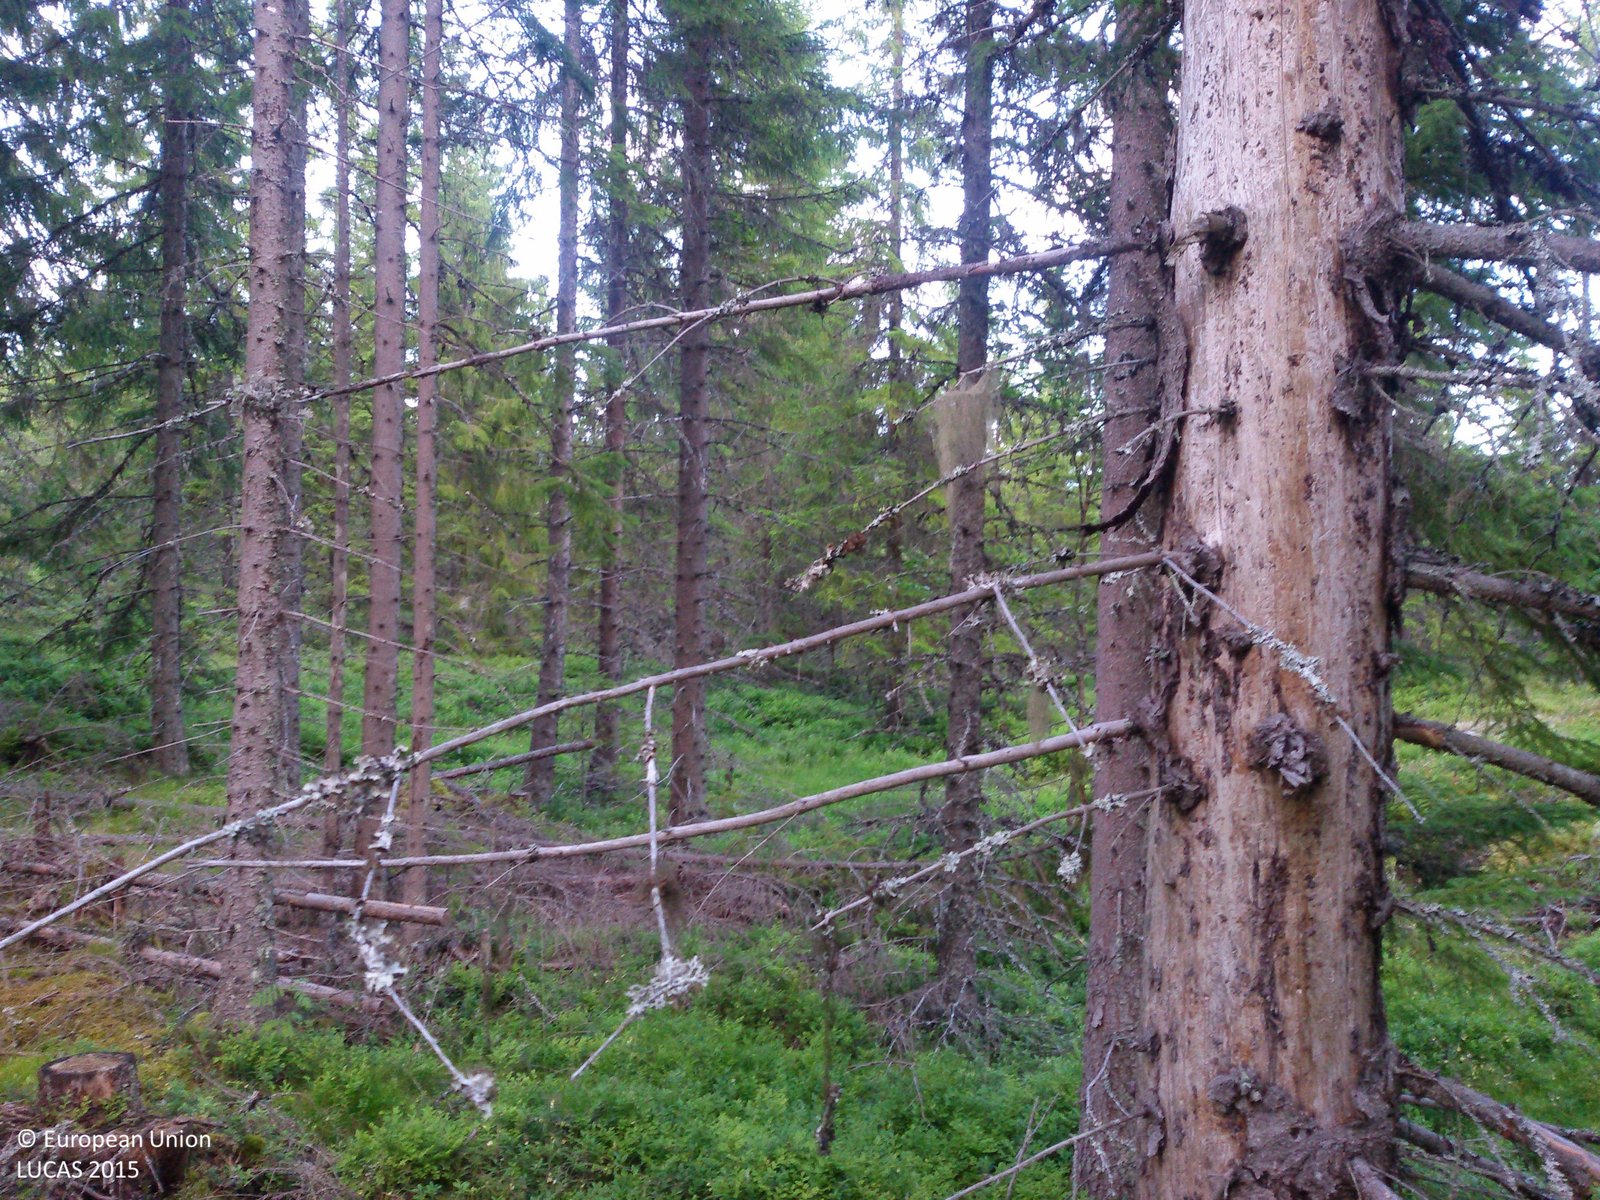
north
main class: Woodland
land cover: Spruce dominated coniferous woodland
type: boreal forest
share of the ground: 50 - 75 %
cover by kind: coniferous forest trees 70 %, herbaceous plants 30 %
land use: Forestry
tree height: > 5 m
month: July
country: SE
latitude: 60.5623
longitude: 14.9673
